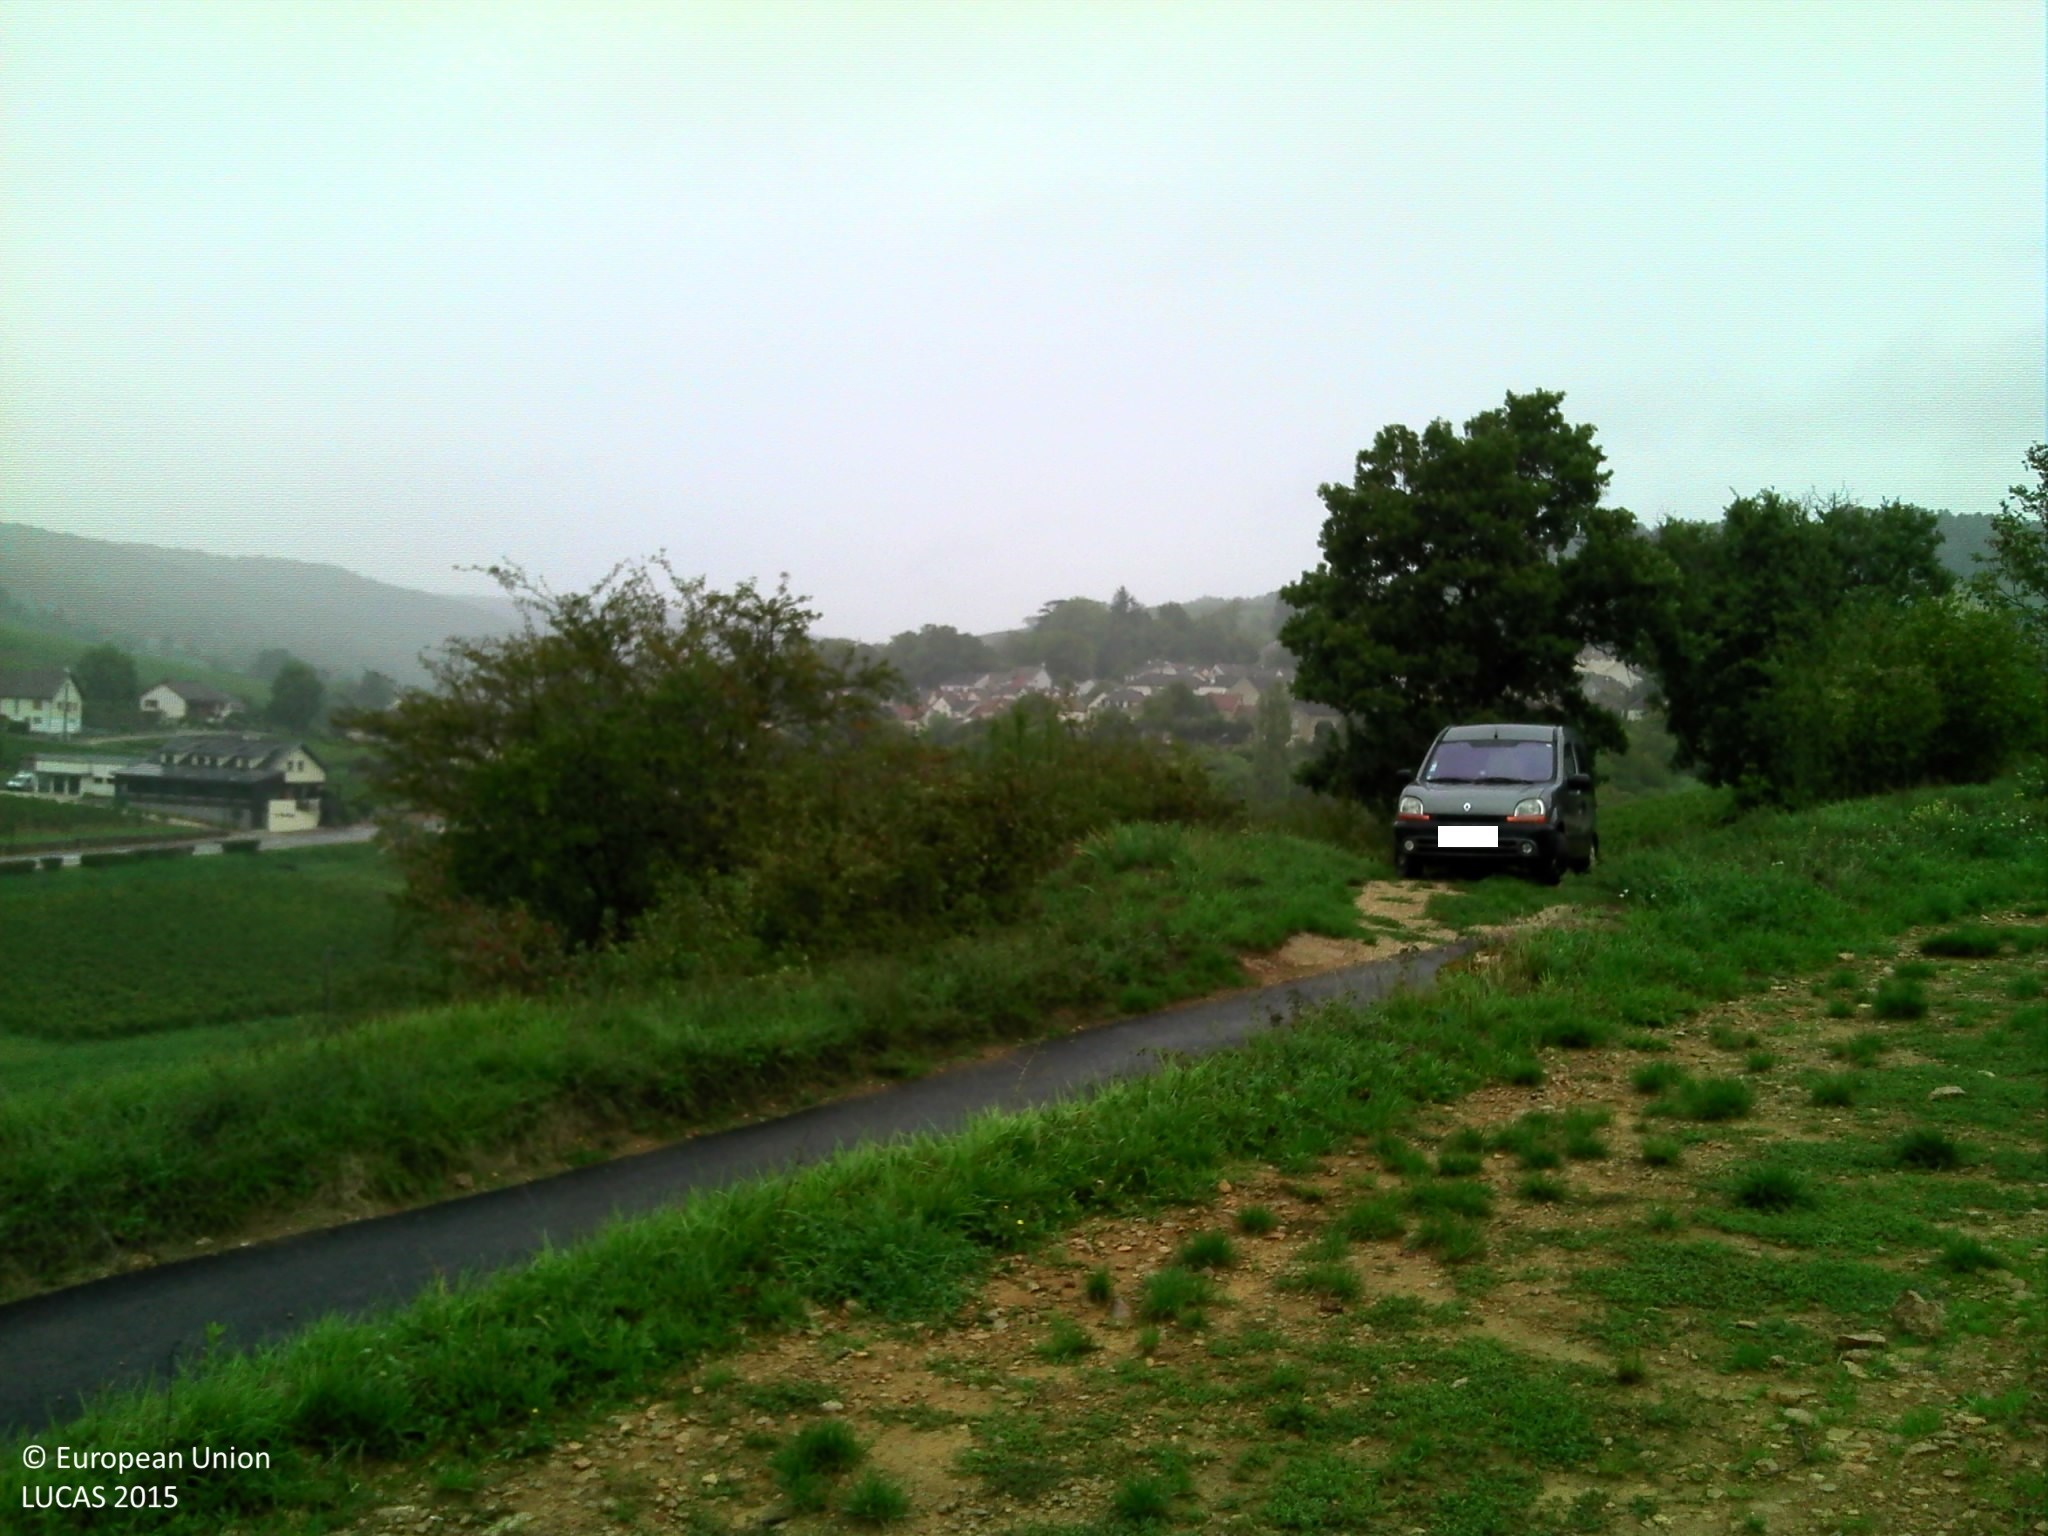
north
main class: Cropland
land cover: Vineyards
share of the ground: 10 - 25 %
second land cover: Other bare soil
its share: > 75 %
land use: Agriculture (excluding fallow land and kitchen gardens)
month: September
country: FR
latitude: 47.0753
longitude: 4.8514
